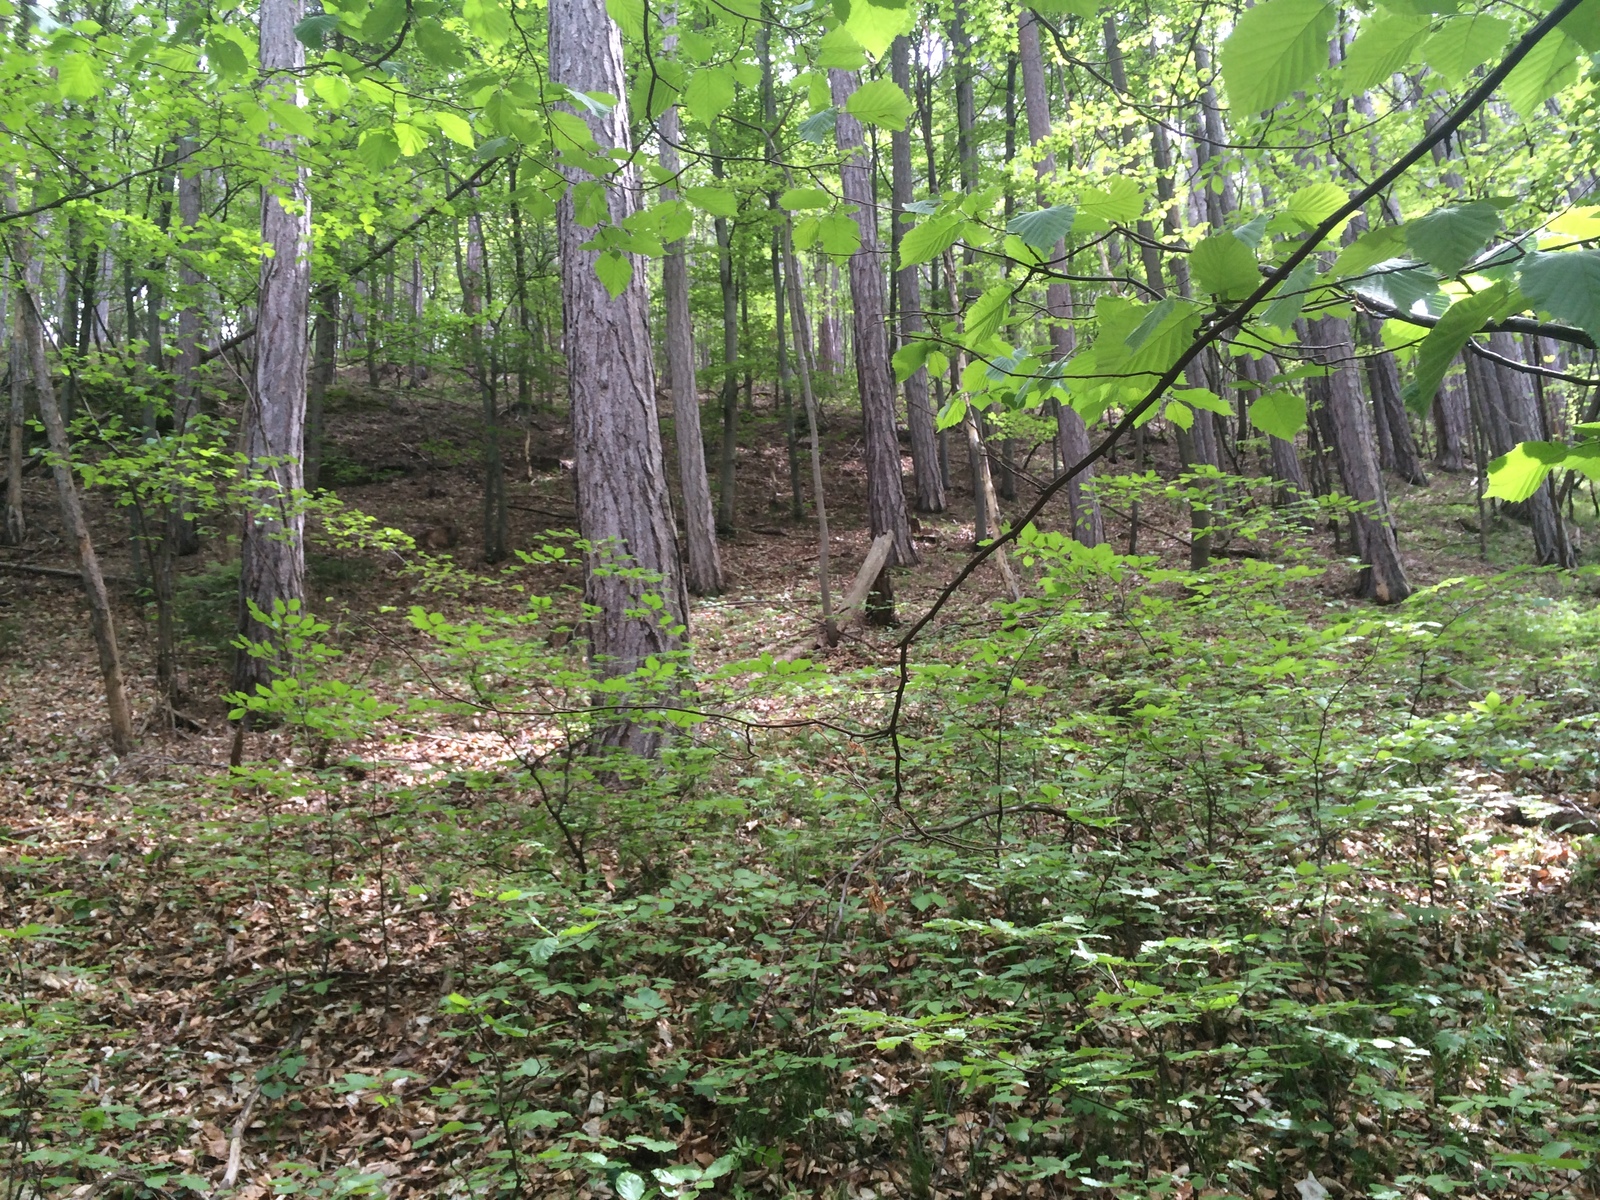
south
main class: Woodland
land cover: Other mixed woodland
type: alpine coniferous forest
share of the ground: > 75 %
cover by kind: broadleaved forest trees 60 %, coniferous forest trees 40 %
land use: Forestry
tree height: > 5 m
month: May
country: AT
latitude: 47.9078
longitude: 16.1445
